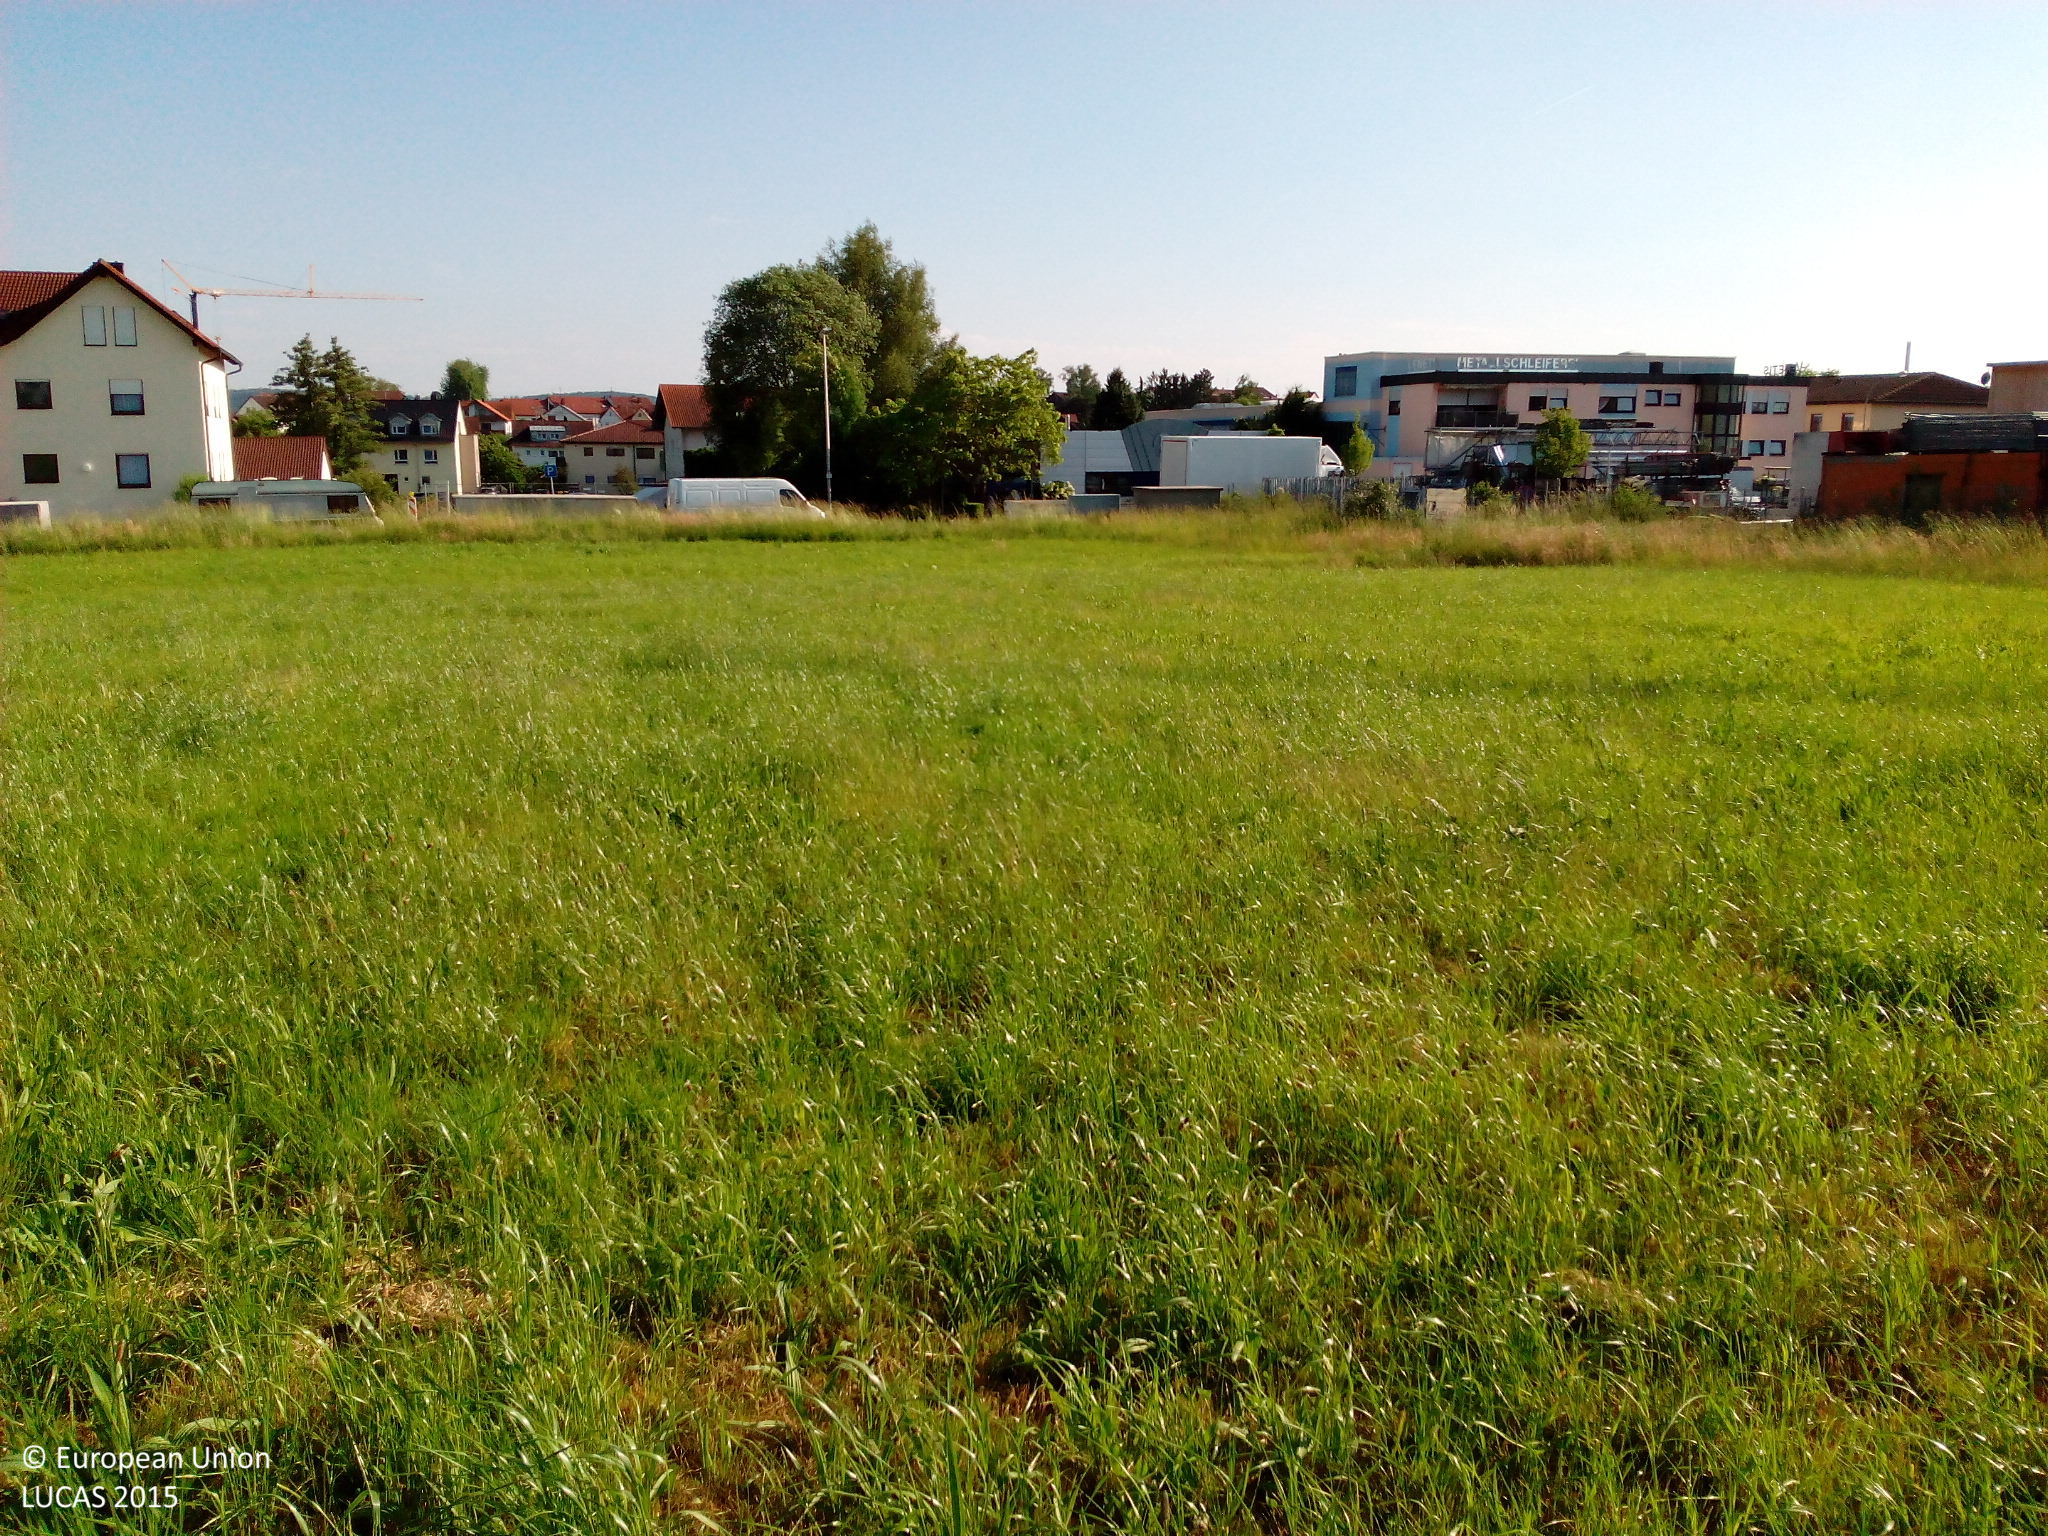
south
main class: Grassland
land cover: Grassland without tree/shrub cover
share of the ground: > 75 %
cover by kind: herbaceous plants 100 %
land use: Agriculture (excluding fallow land and kitchen gardens)
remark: Harvested field
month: June
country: DE
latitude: 48.9057
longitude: 9.4136
